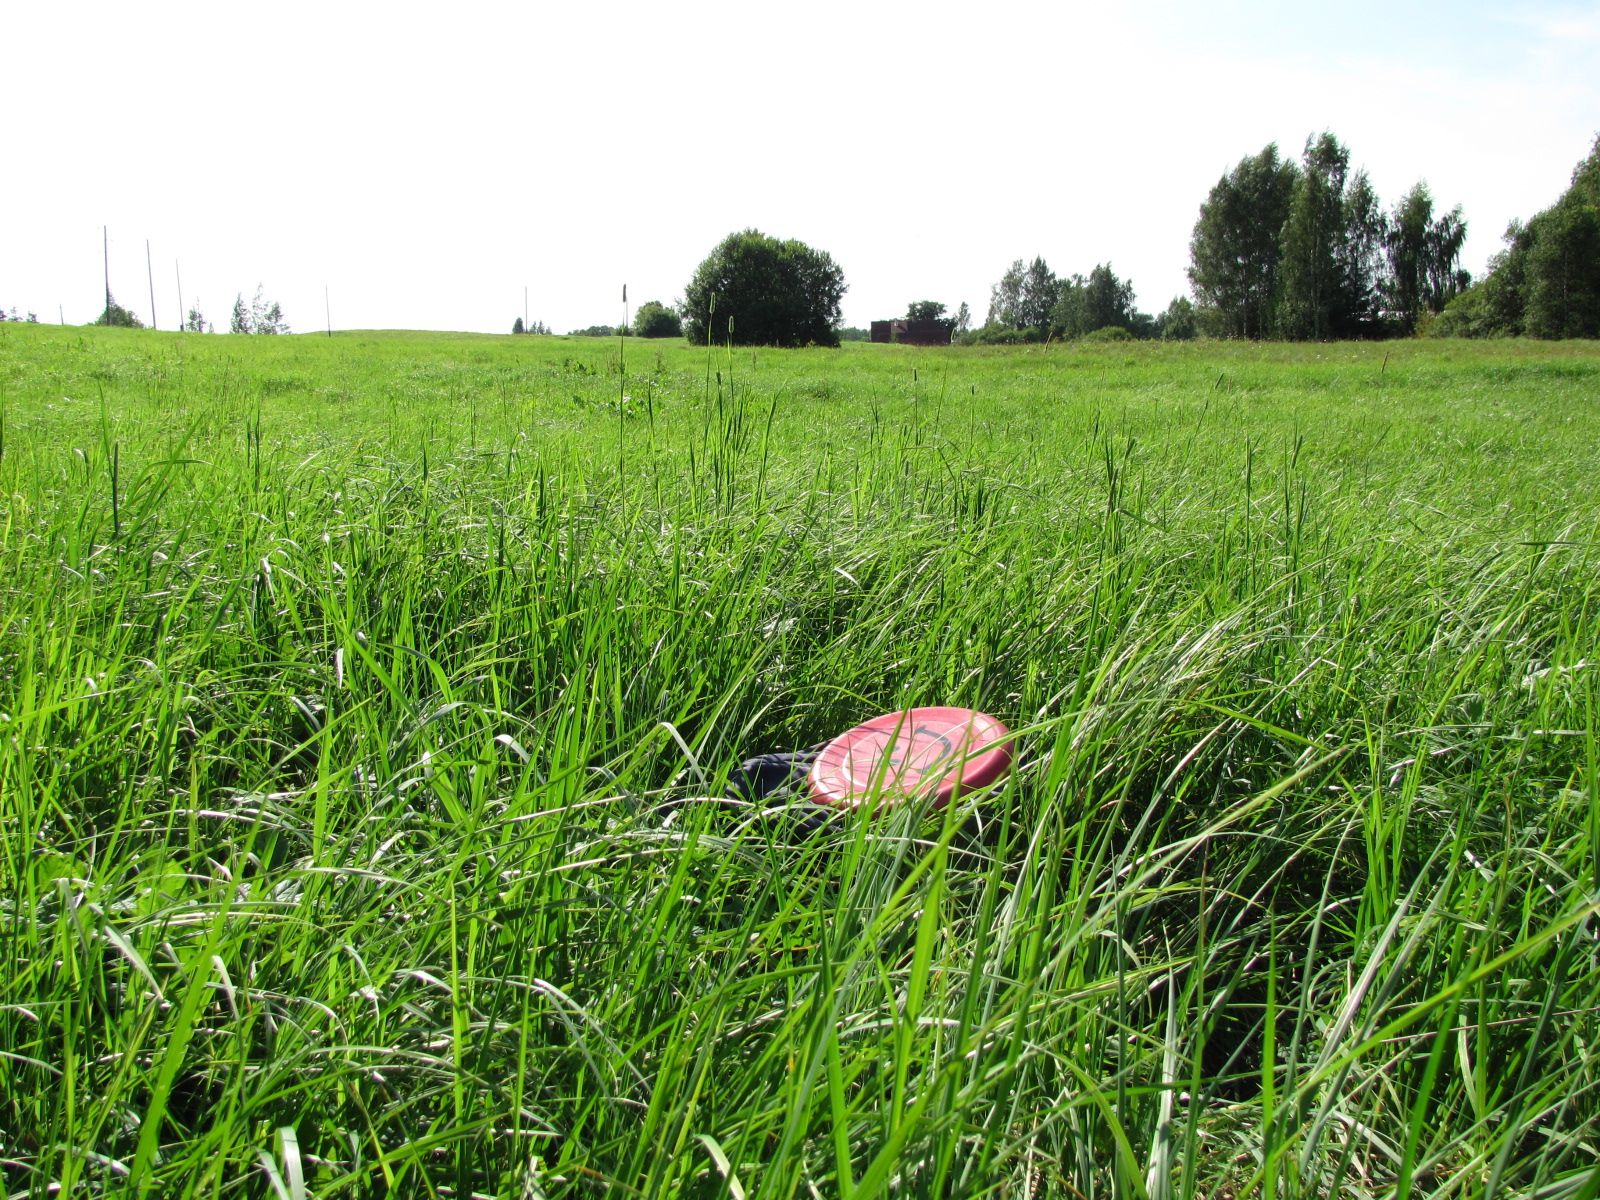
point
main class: Grassland
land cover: Grassland without tree/shrub cover
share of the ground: > 75 %
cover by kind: herbaceous plants 100 %
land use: Agriculture (excluding fallow land and kitchen gardens)
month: August
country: LV
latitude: 56.9904
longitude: 25.2702
